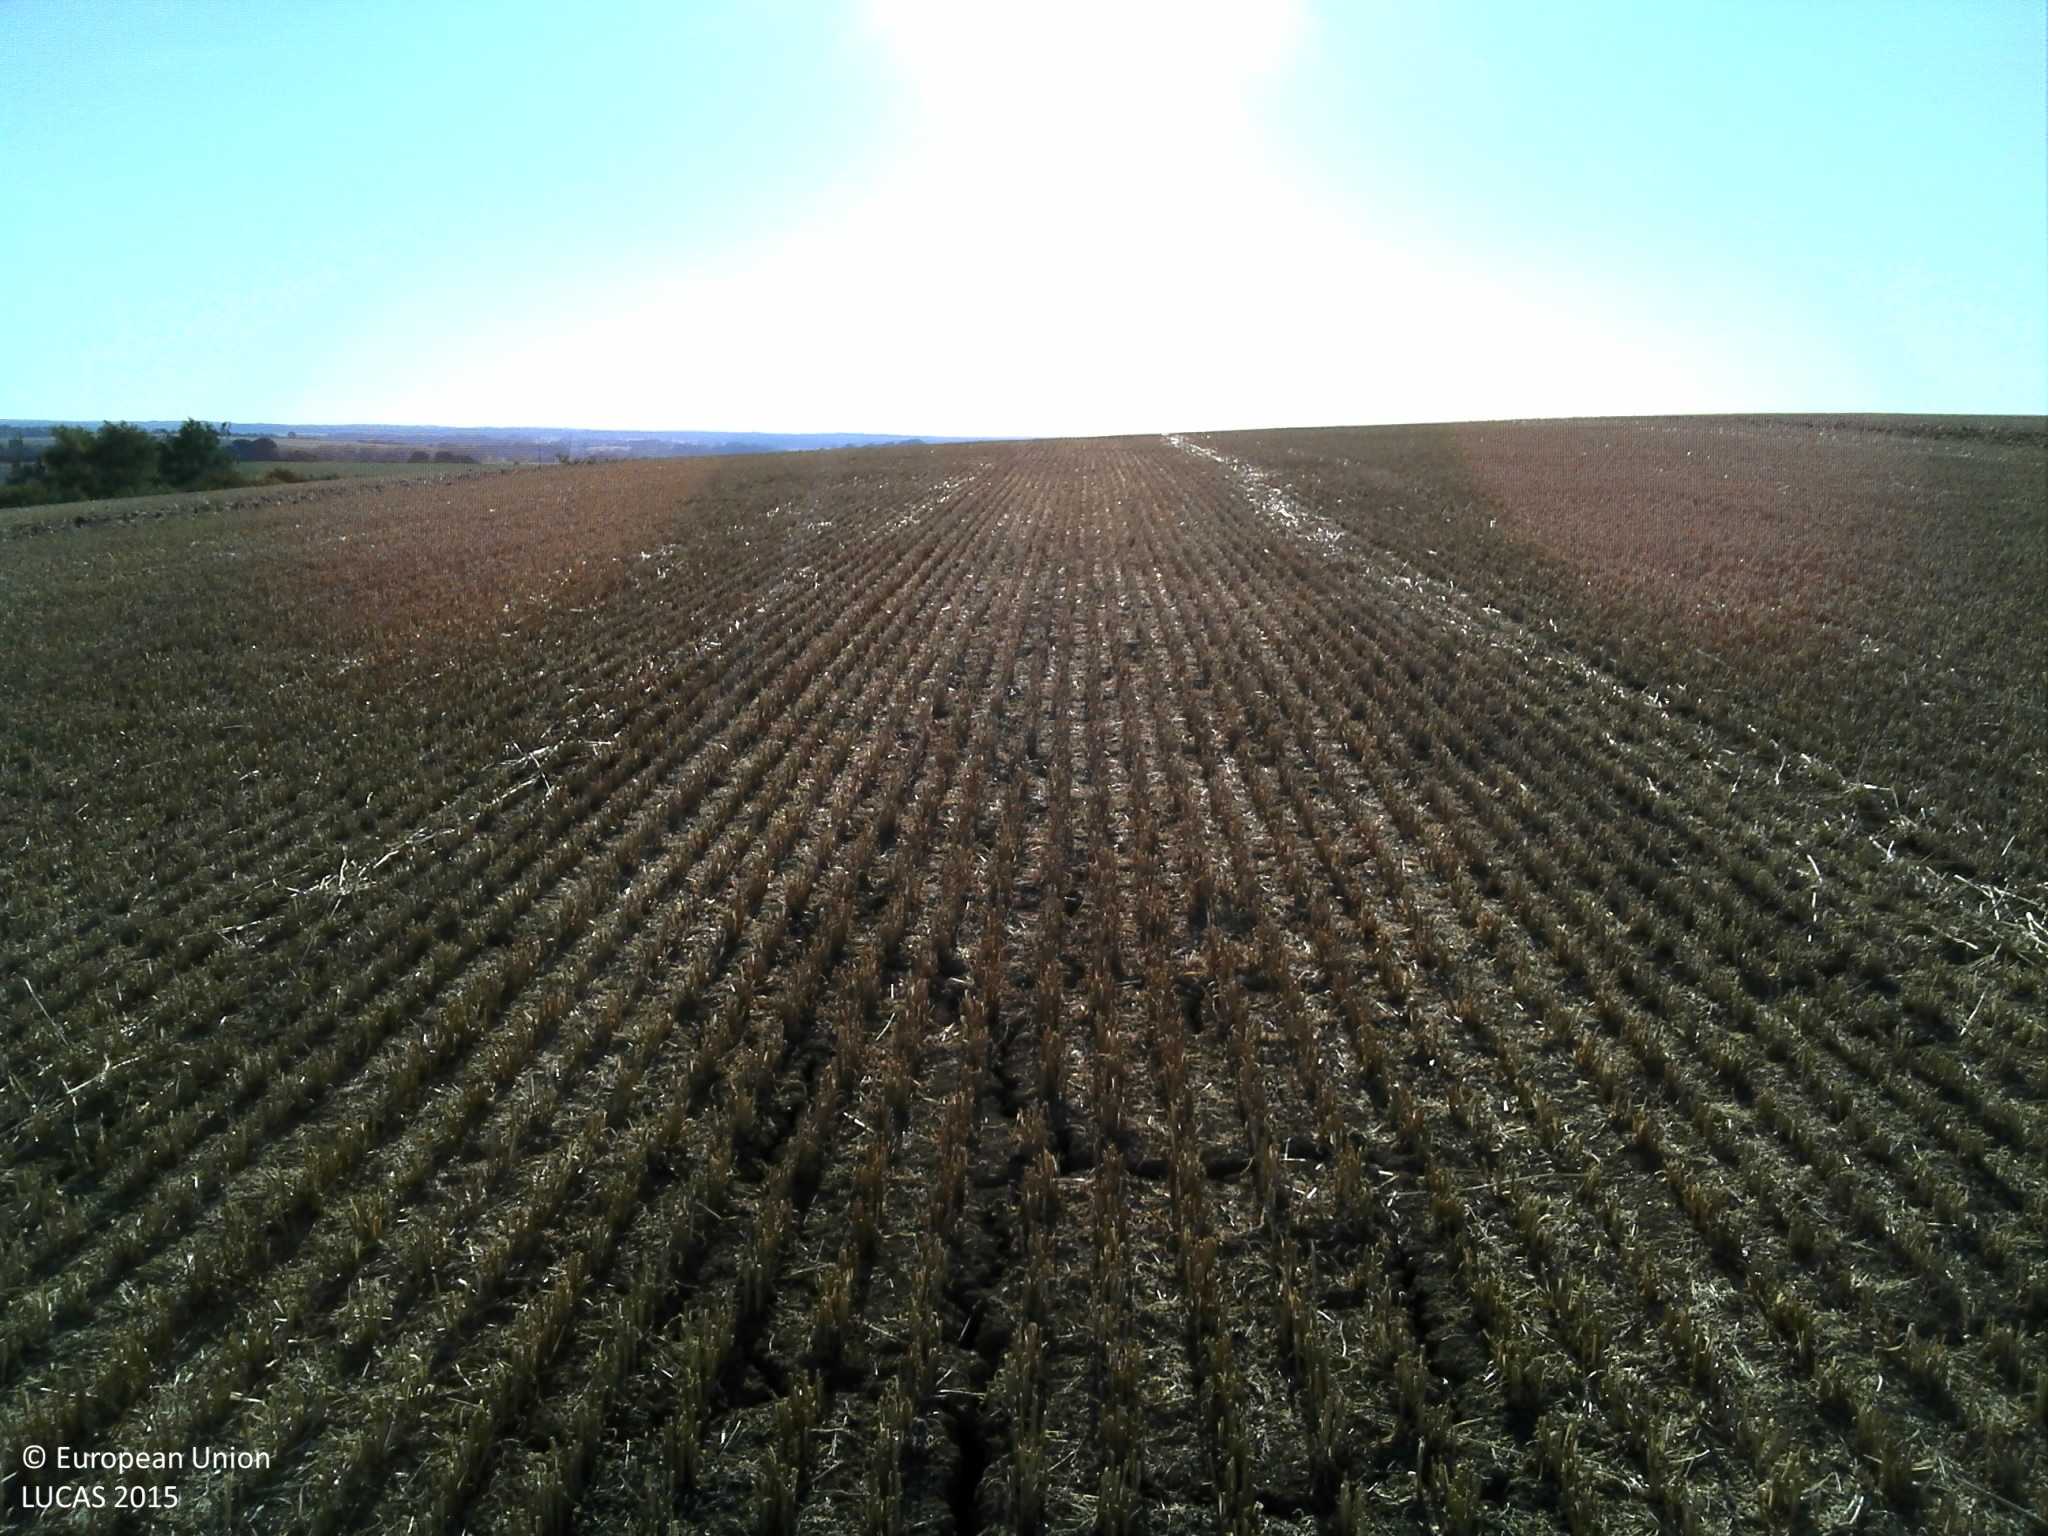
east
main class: Cropland
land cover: Common wheat
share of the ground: > 75 %
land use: Agriculture (excluding fallow land and kitchen gardens)
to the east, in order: Common wheat
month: August
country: FR
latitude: 49.1107
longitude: 4.8053
